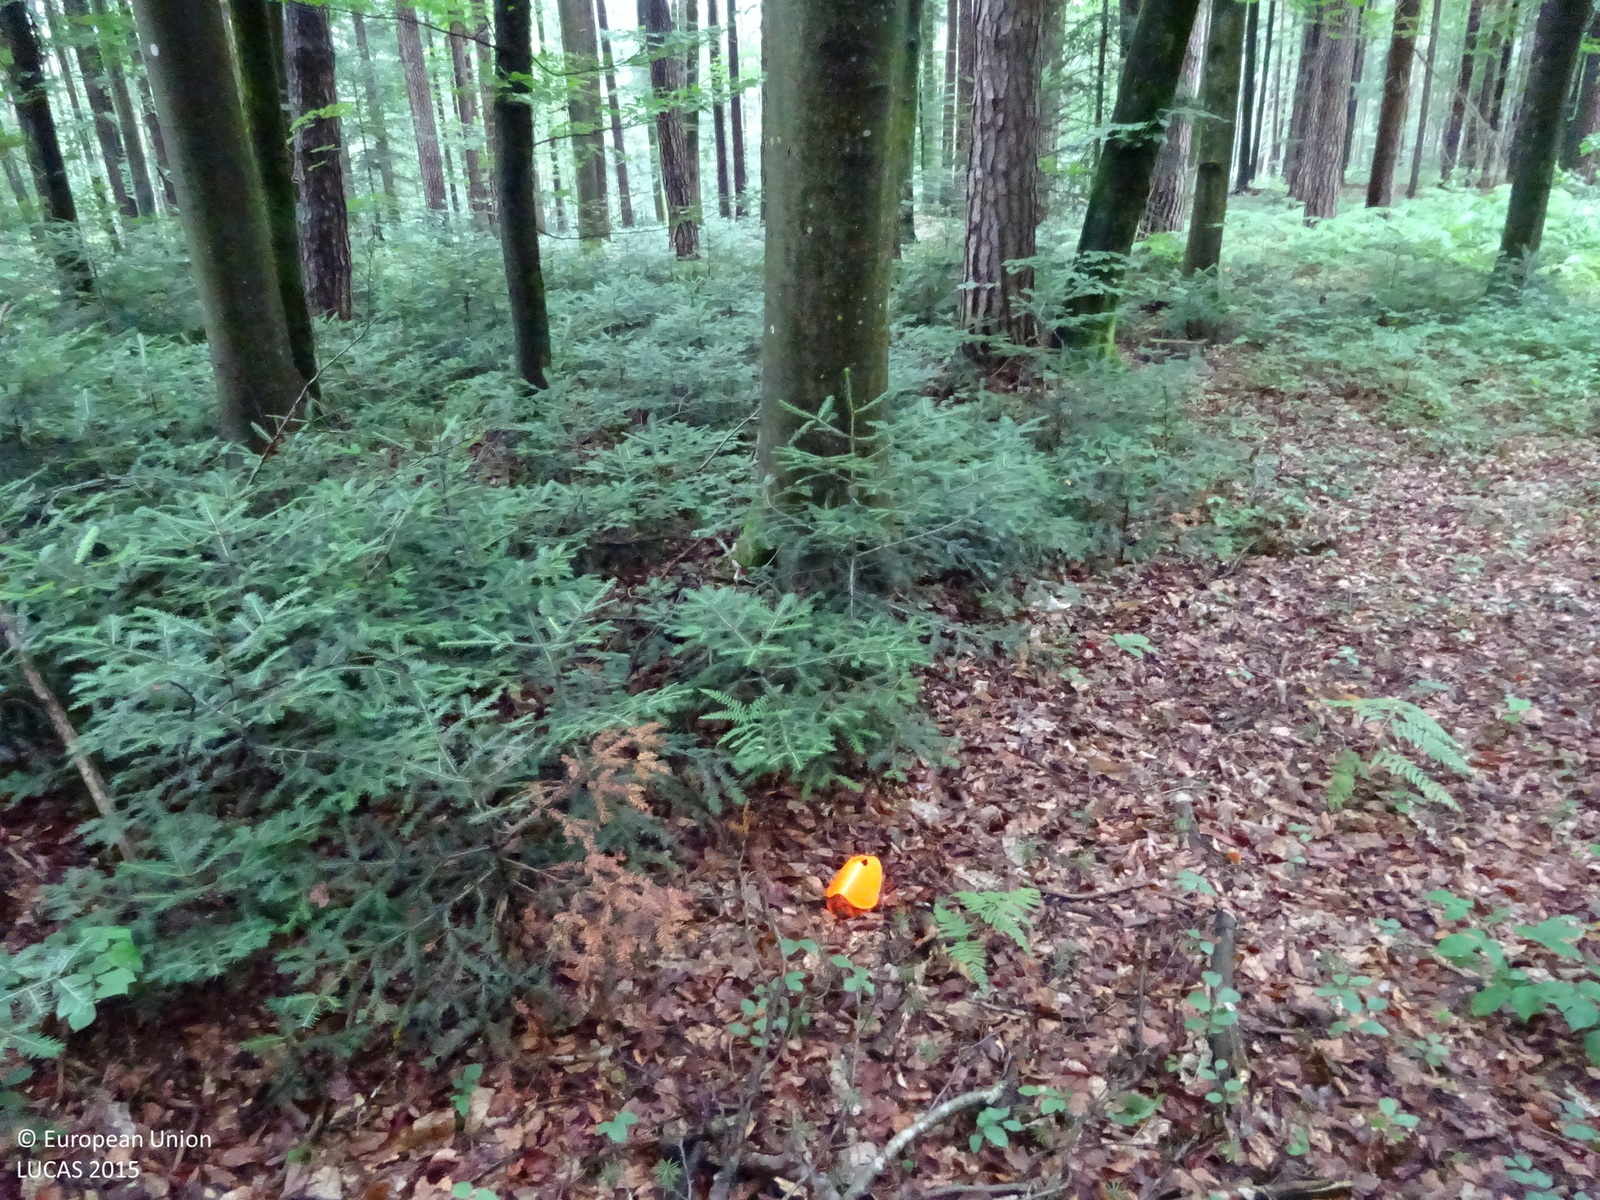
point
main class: Woodland
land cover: Pine dominated mixed woodland
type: mountainous beech forest
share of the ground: > 75 %
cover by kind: broadleaved forest trees 70 %, coniferous forest trees 30 %
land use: Forestry
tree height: > 5 m
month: June
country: AT
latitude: 46.7099
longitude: 15.2440
